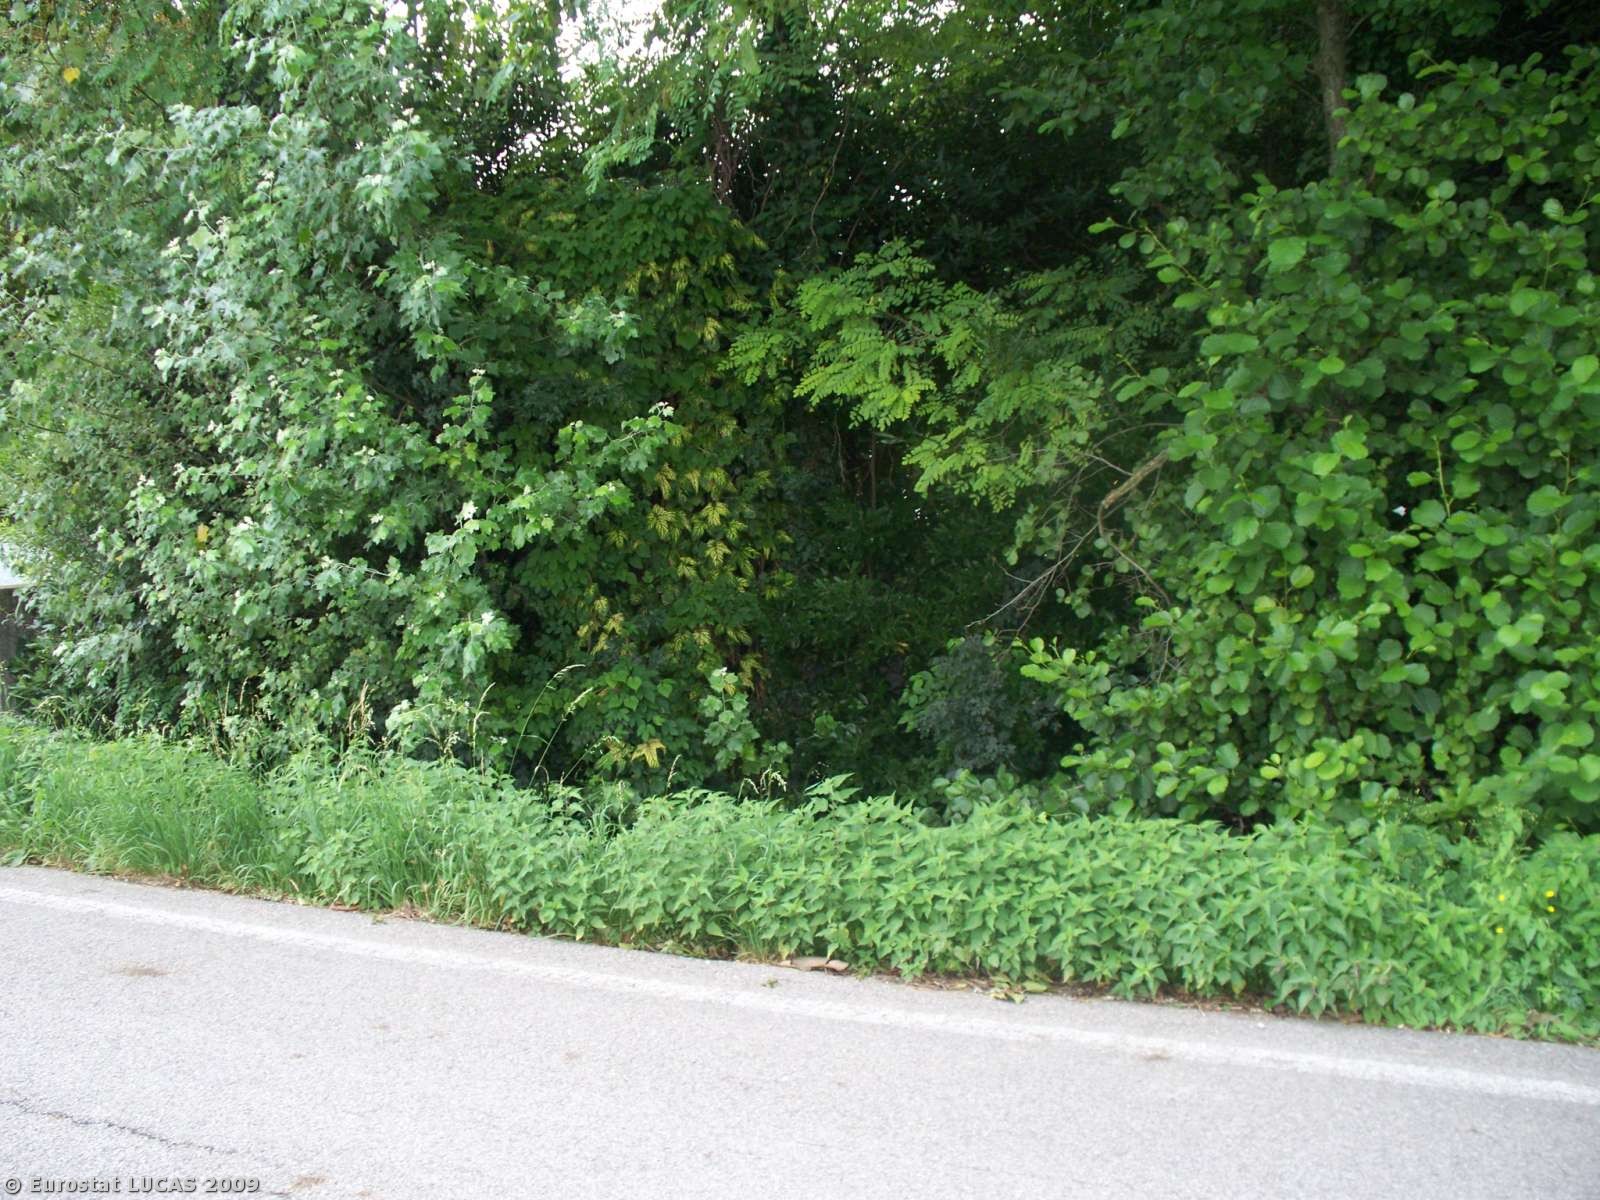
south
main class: Cropland
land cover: Maize
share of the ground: > 75 %
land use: Agriculture (excluding fallow land and kitchen gardens)
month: July
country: IT
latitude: 45.8190
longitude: 12.4292
